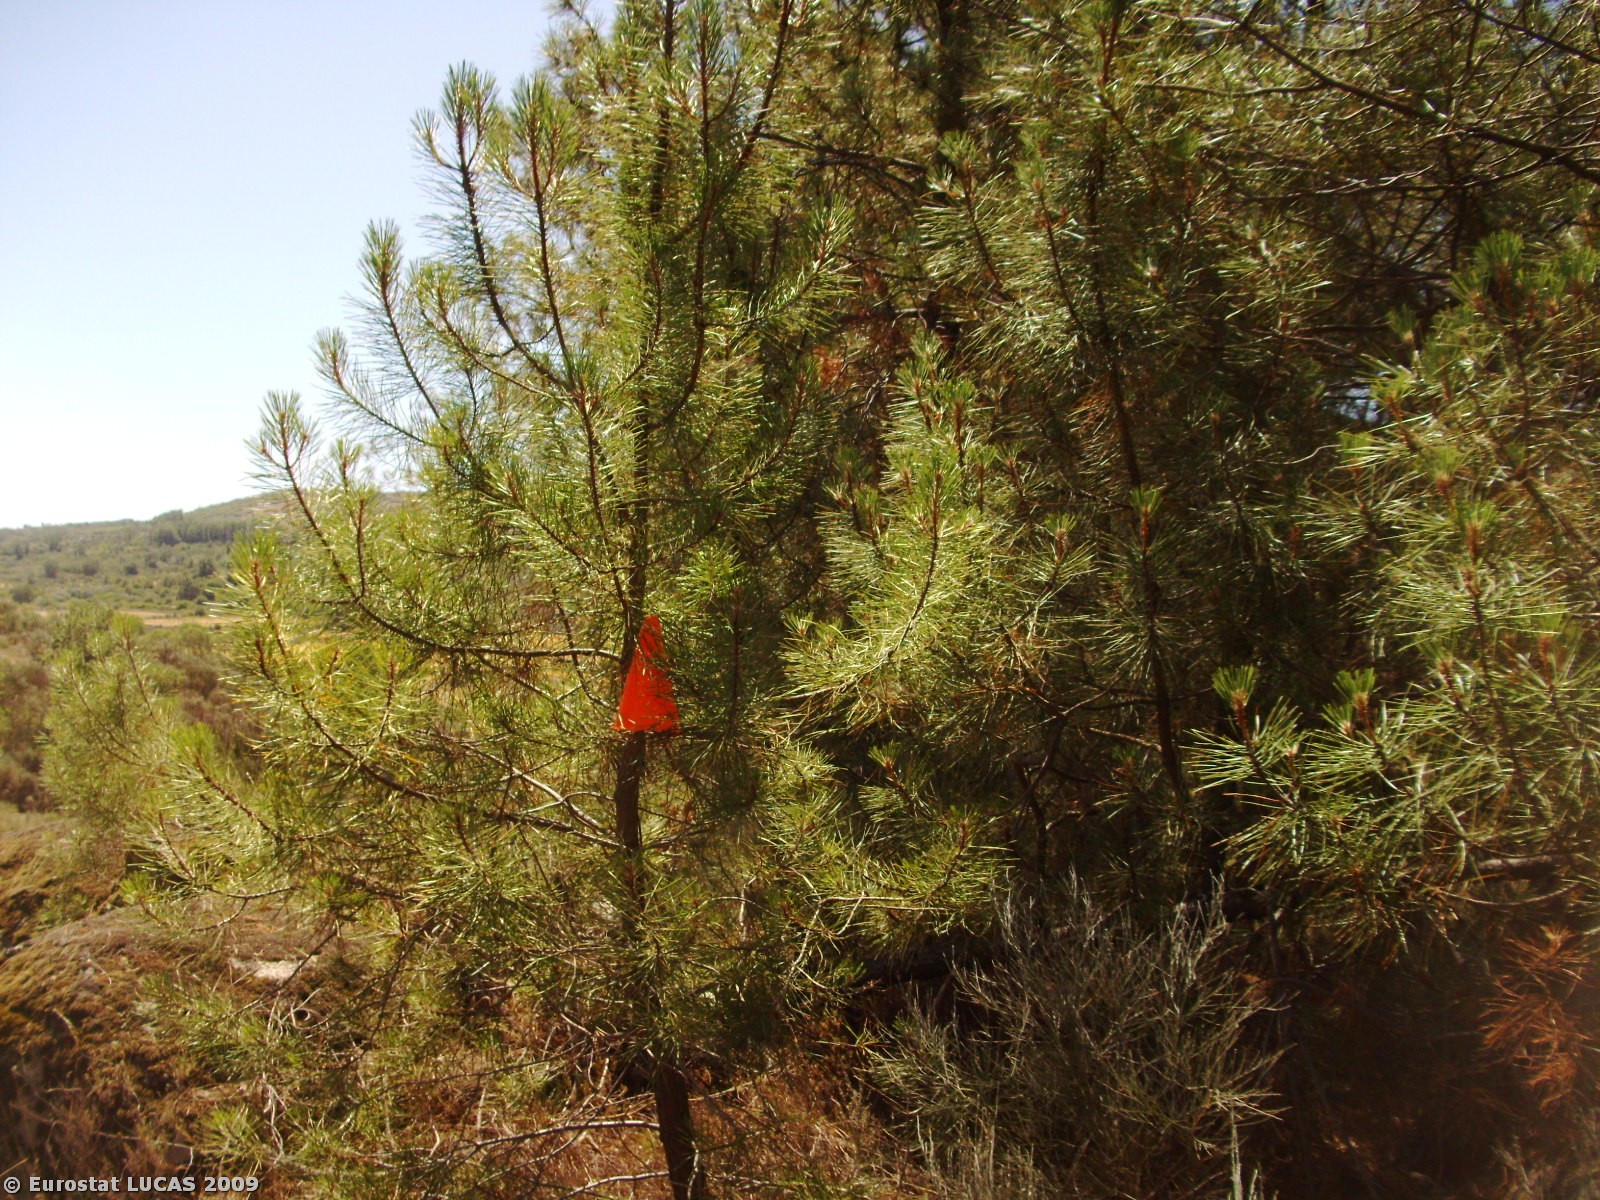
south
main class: Woodland
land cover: Coniferous woodland
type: coniferous forest of the mediterranean region
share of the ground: 50 - 75 %
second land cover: Shrubland with sparse tree cover
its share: < 10 %
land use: Forestry
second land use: Unused
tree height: > 5 m
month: July
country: PT
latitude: 40.3000
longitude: -7.2186
